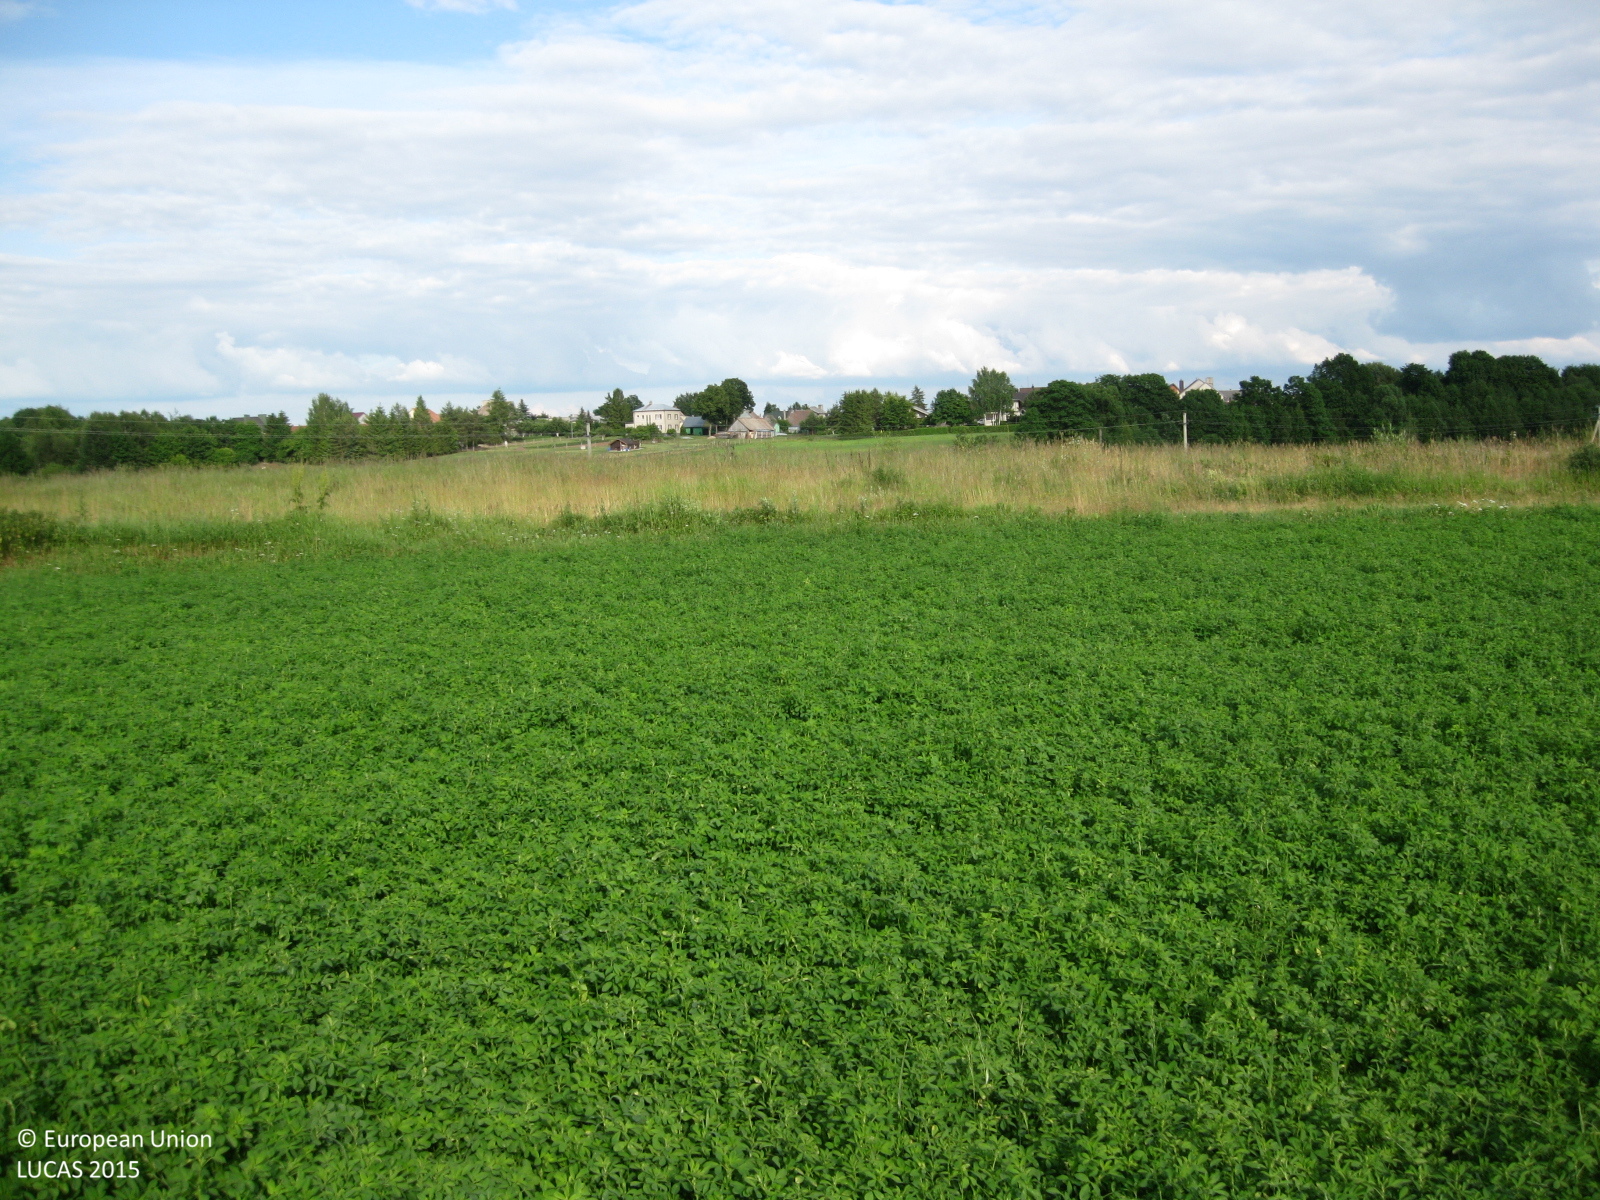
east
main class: Cropland
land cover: Clovers
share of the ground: > 75 %
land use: Agriculture (excluding fallow land and kitchen gardens)
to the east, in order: Clovers; Spontaneously vegetated surfaces; Tracks; Spontaneously vegetated surfaces; Clovers; Electric lines; Clovers; Spontaneously vegetated surfaces; Inland fresh water bodies
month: June
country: LT
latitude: 55.1892
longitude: 23.8945
